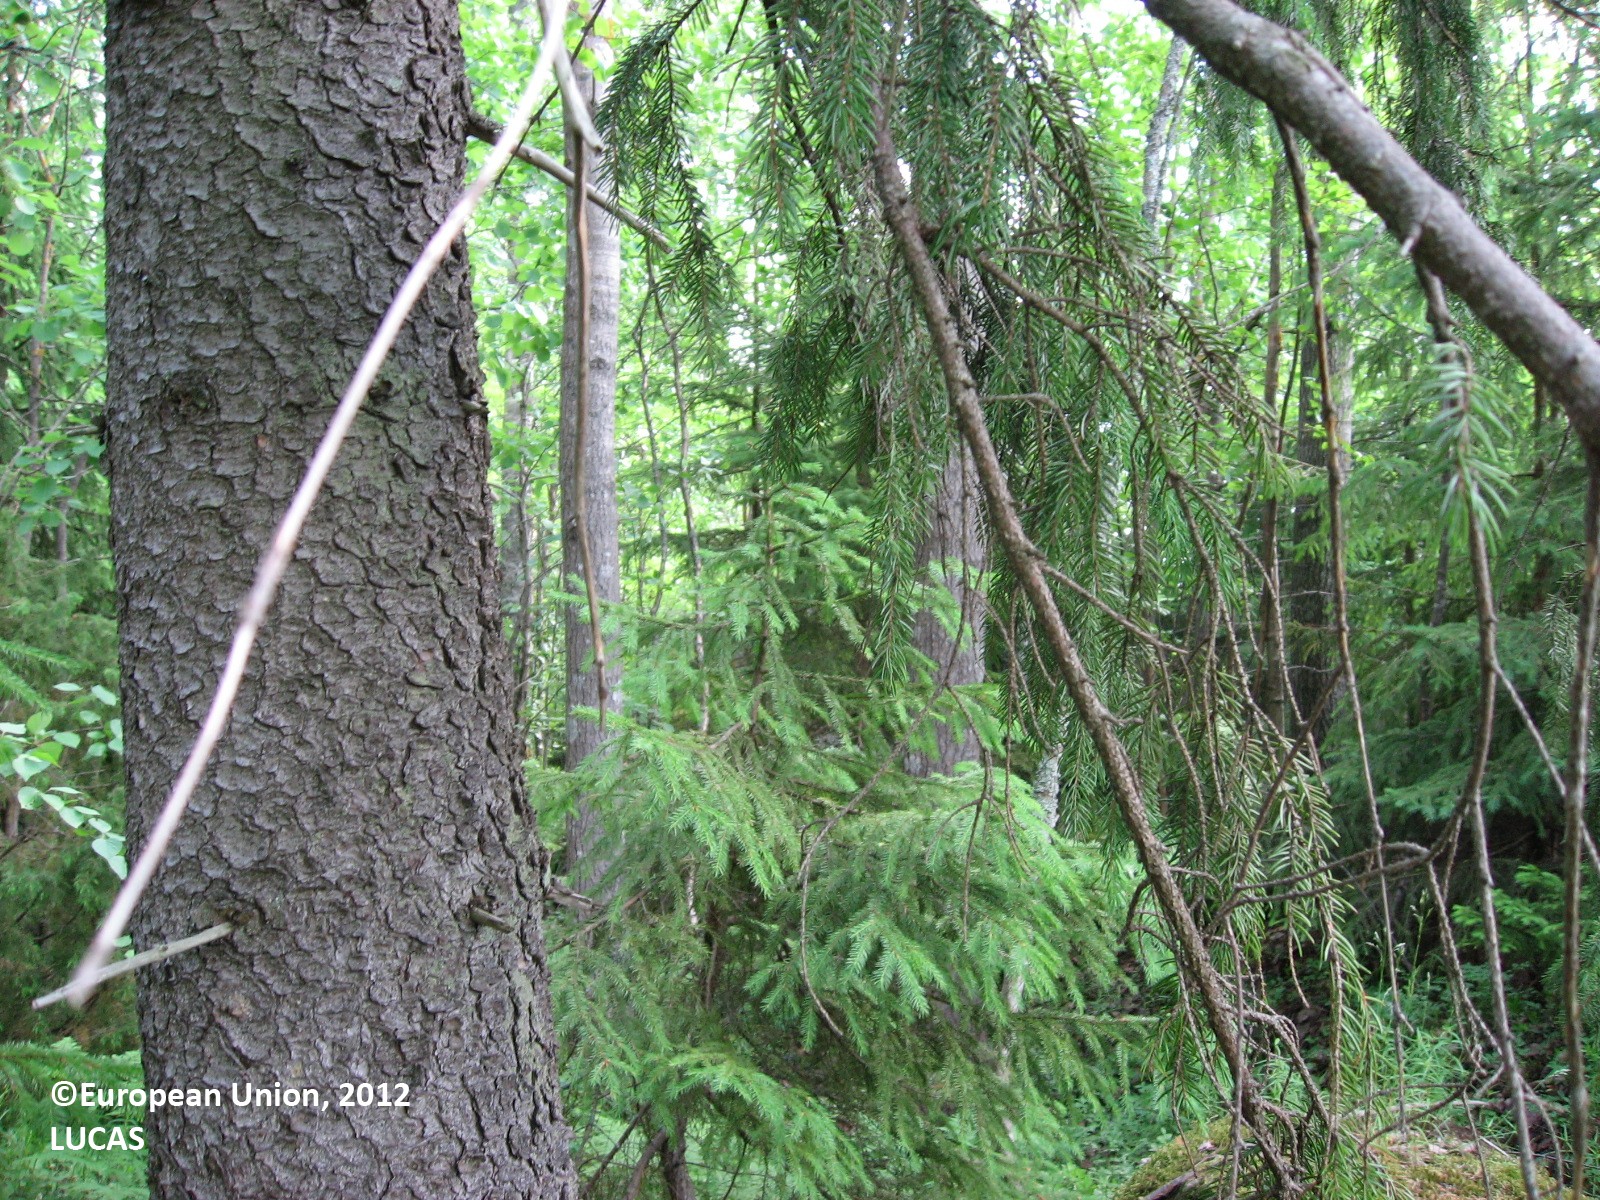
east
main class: Woodland
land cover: Spruce dominated mixed woodland
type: boreal forest
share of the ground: > 75 %
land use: Forestry
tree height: > 5 m
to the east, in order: Spruce dominated mixed woodland; Ditches and canals; Spruce dominated mixed woodland; Fences; Electric lines; Grass margins; Paved roads, cycling and walking lanes; Grass margins; Fences; Other mixed woodland
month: June
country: FI
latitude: 60.4884
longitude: 26.5175
